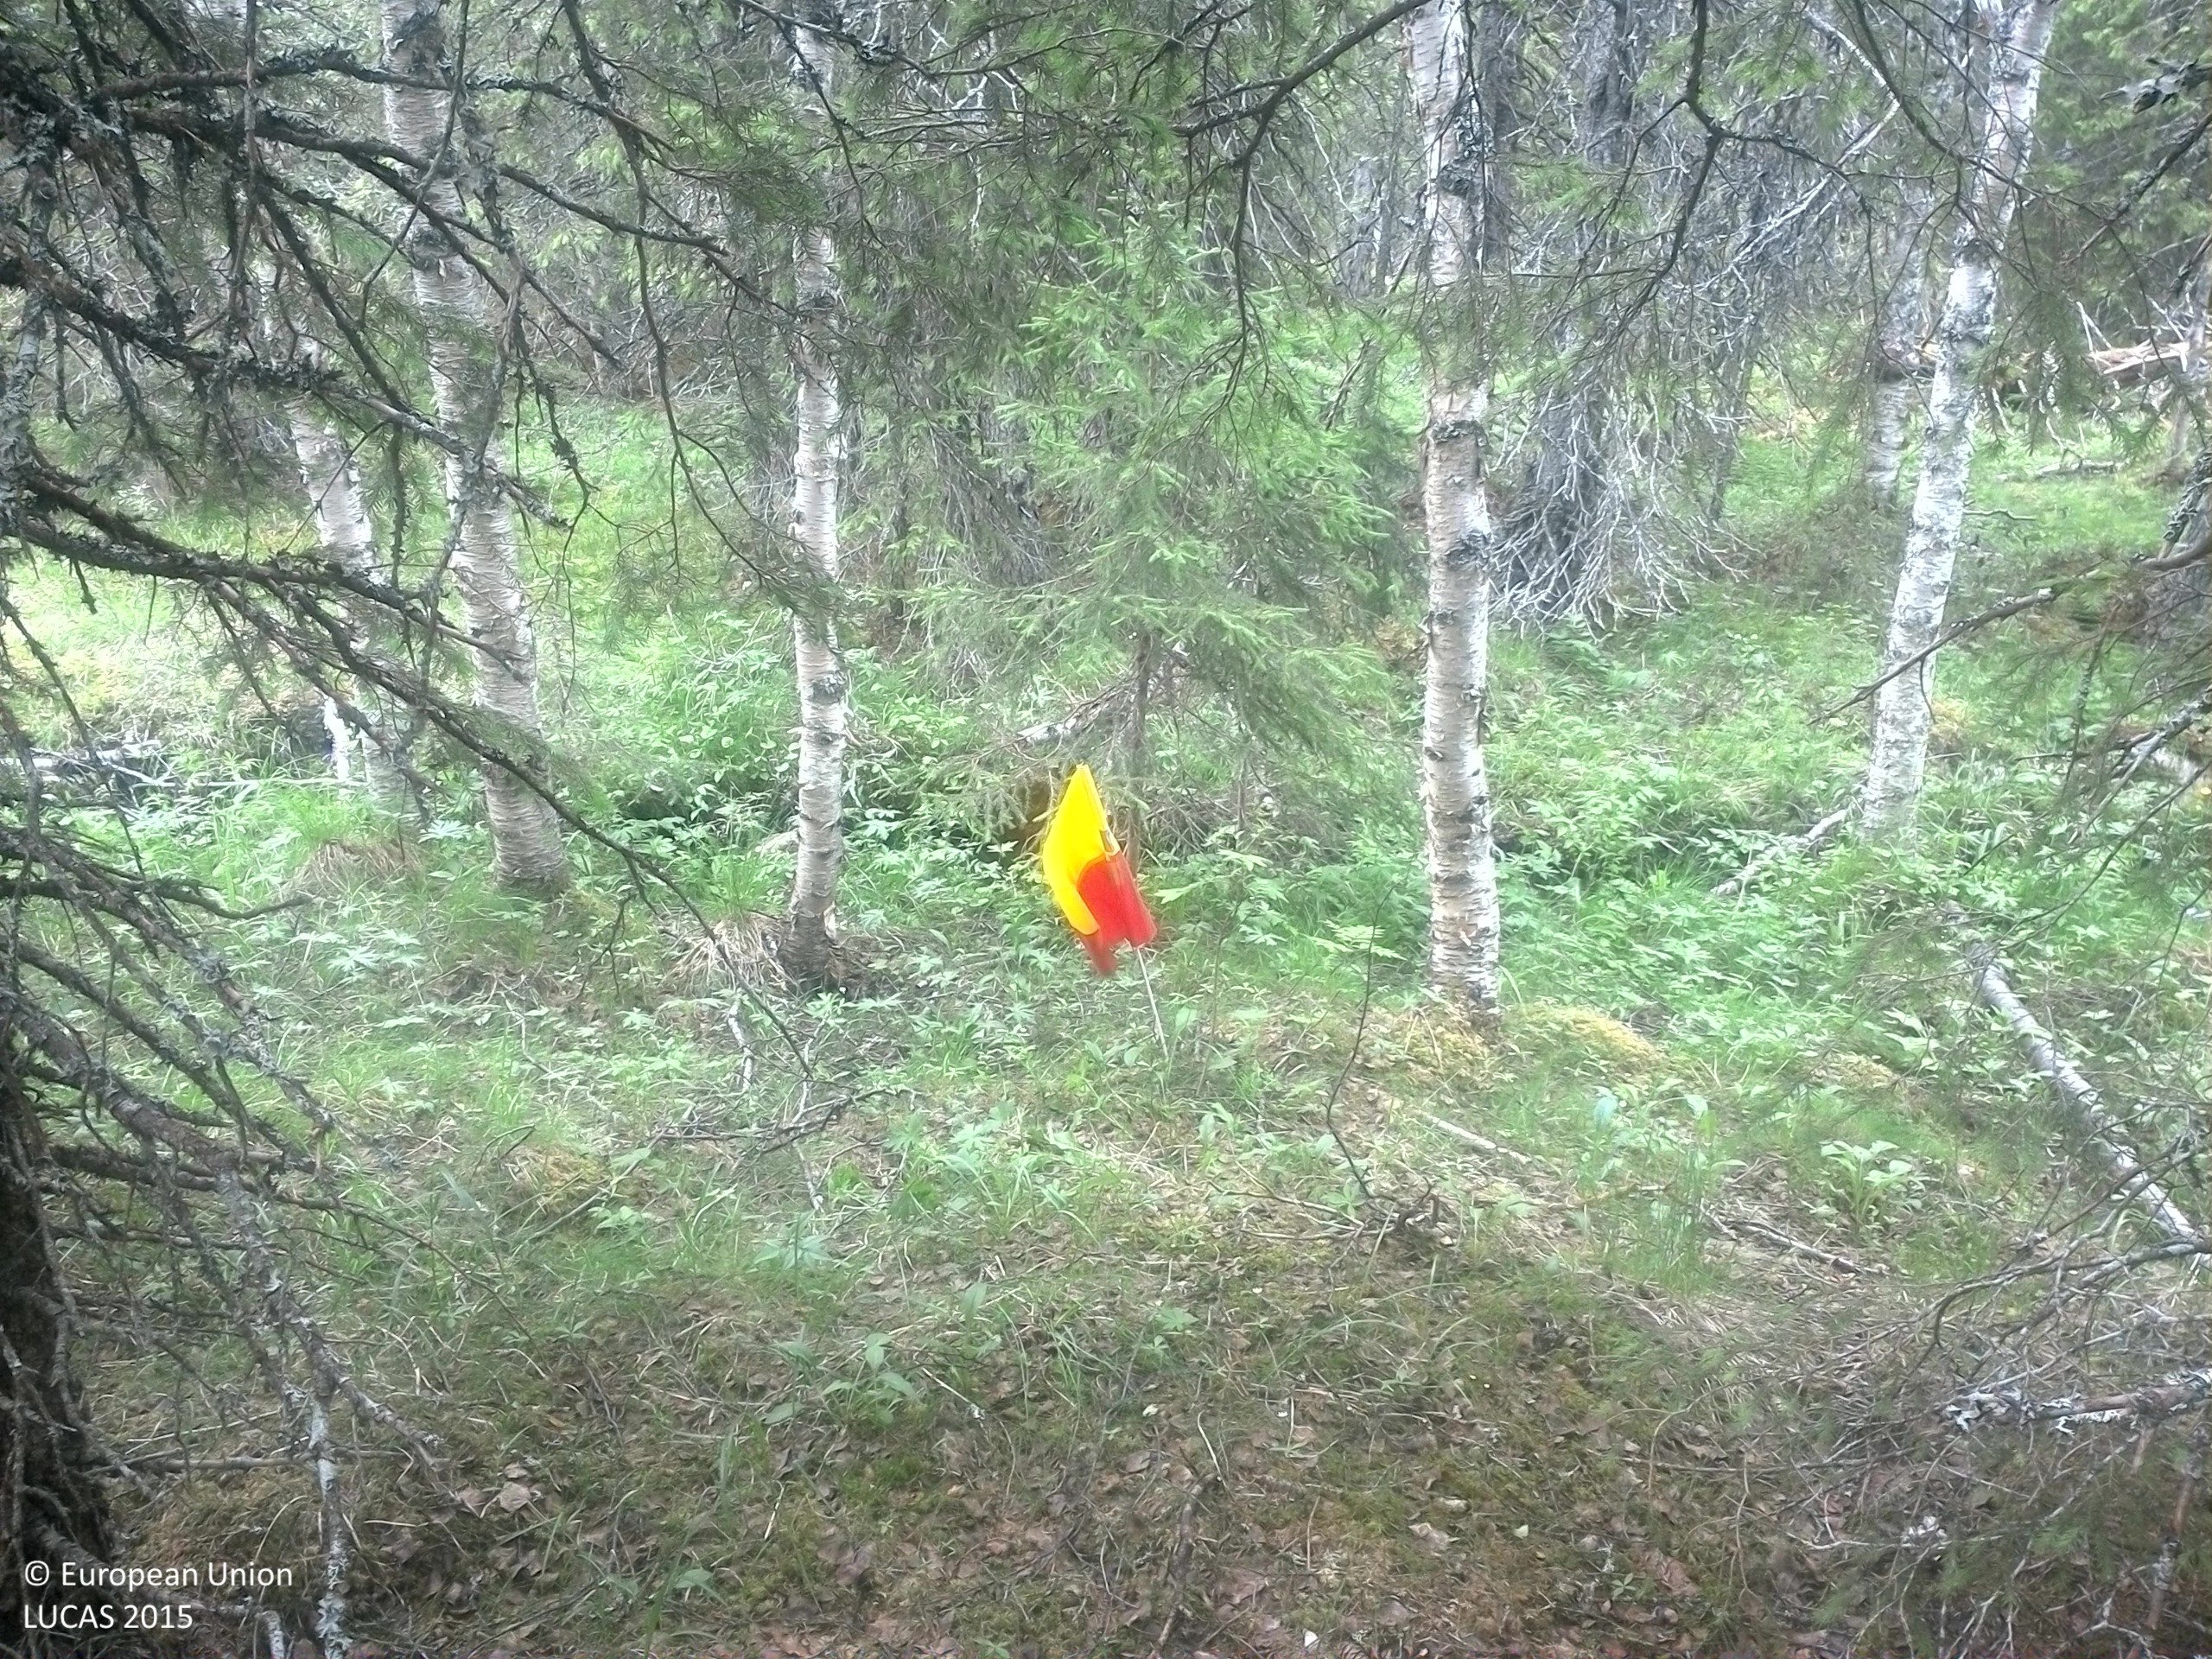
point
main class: Woodland
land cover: Spruce dominated coniferous woodland
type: boreal forest
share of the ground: 50 - 75 %
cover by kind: coniferous forest trees 50 %, herbaceous plants 15 %, lichens and mosses 15 %, broadleaved forest trees 10 %, shrubs 10 %
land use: Forestry
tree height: > 5 m
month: July
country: SE
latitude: 64.7304
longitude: 15.7000
